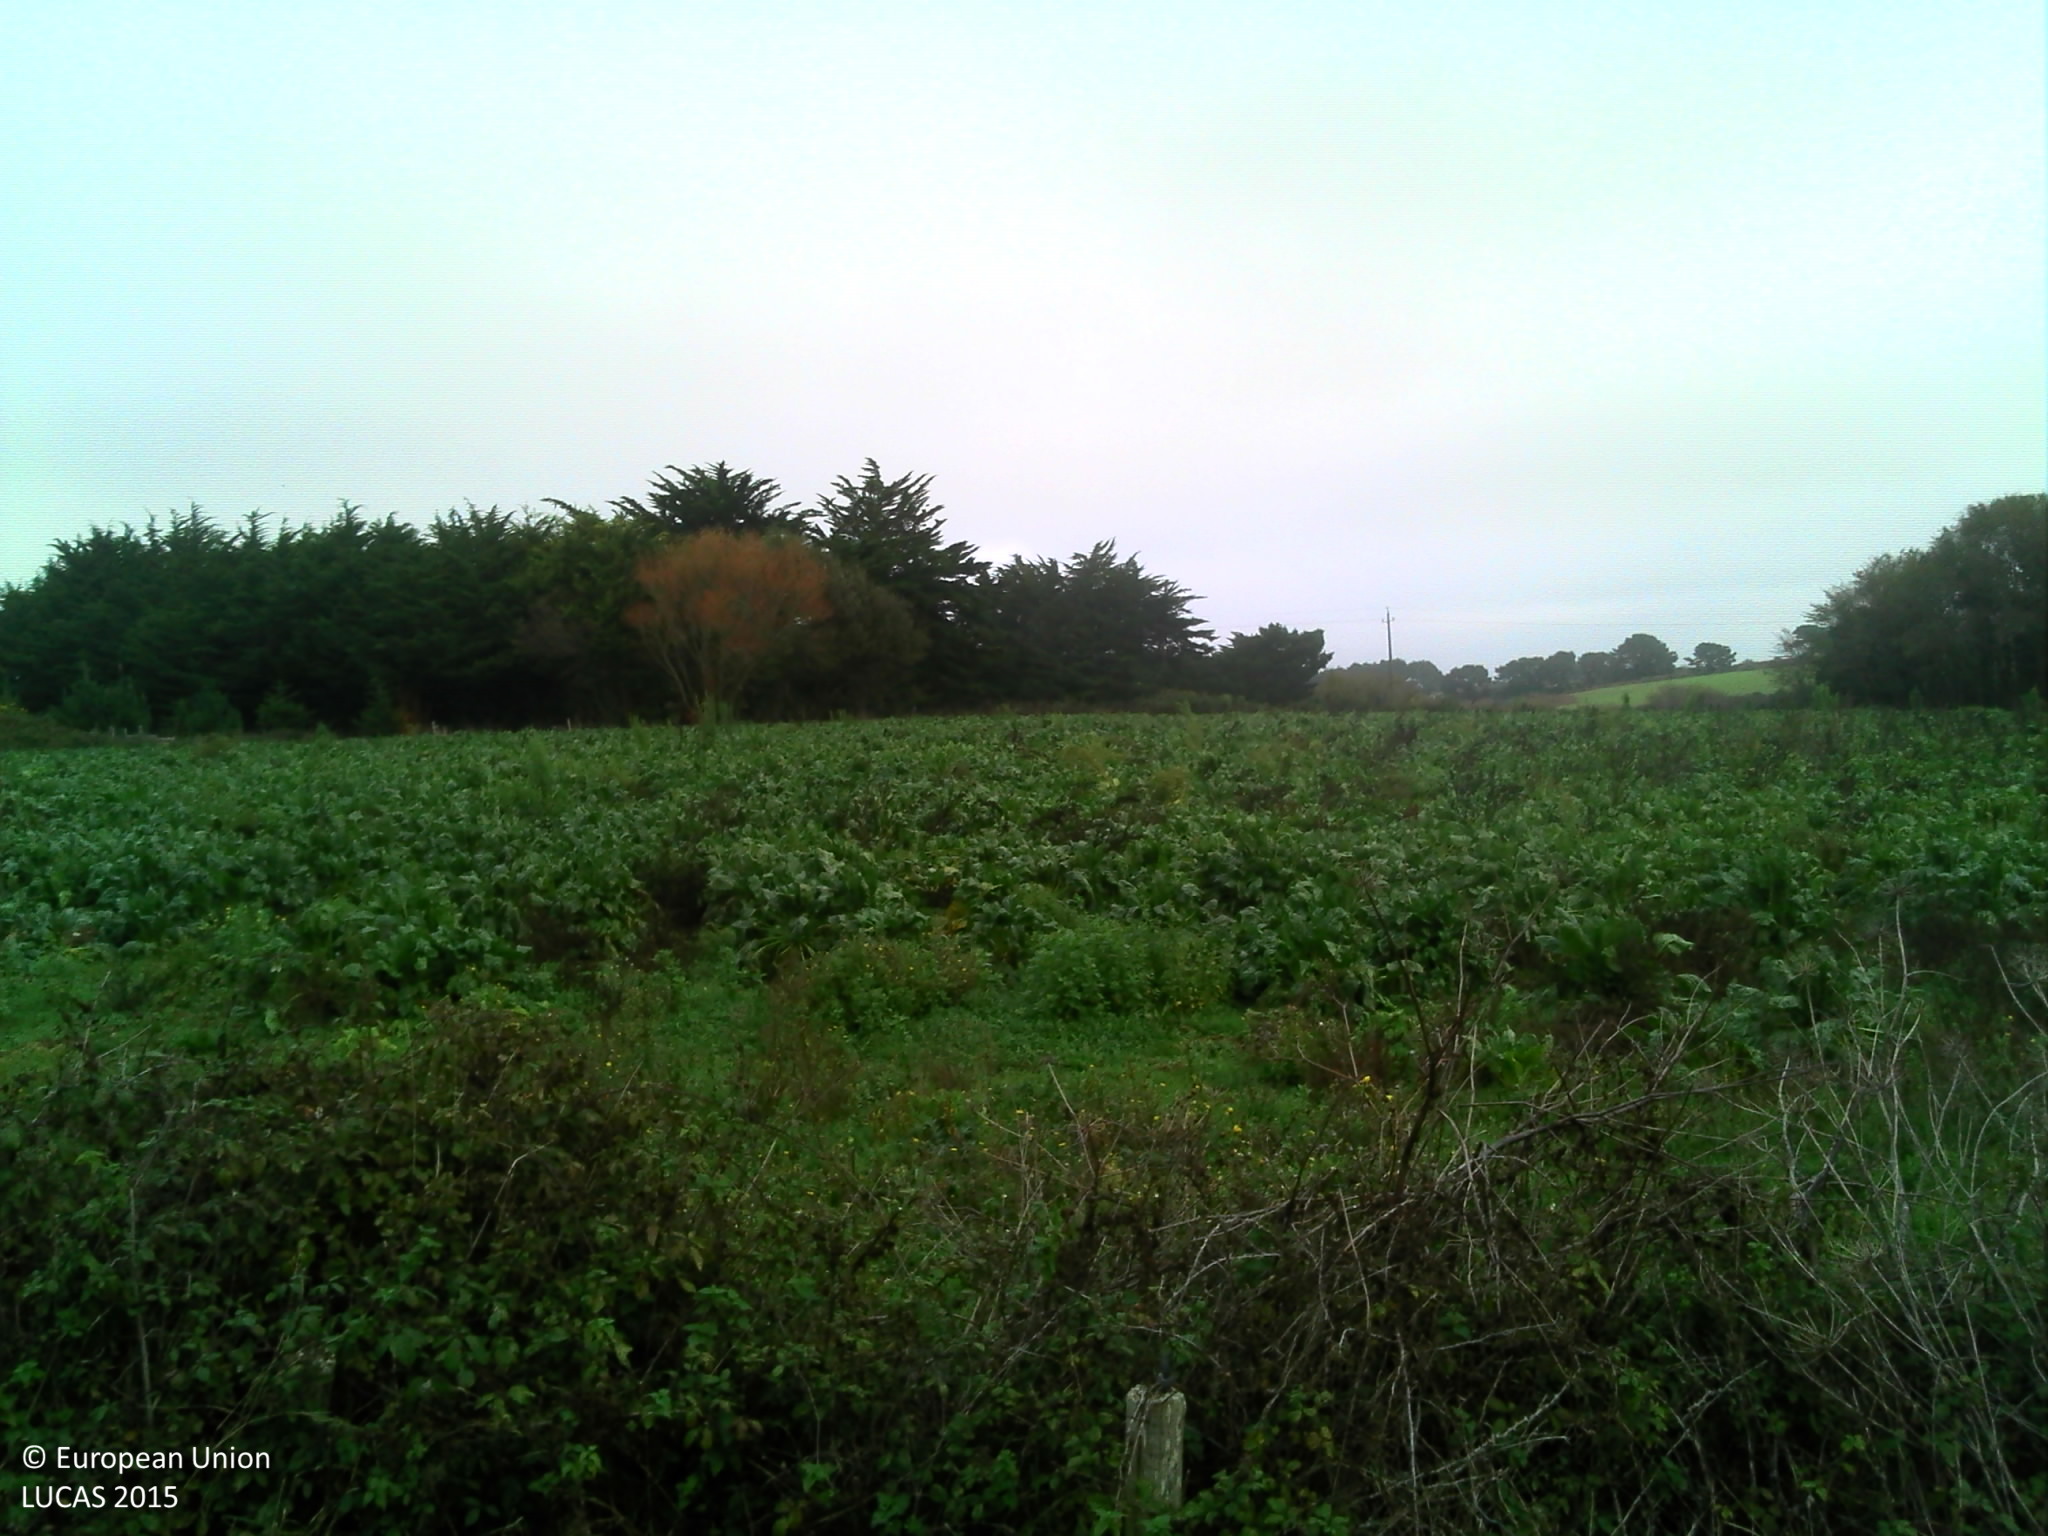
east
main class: Shrubland
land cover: Shrubland with sparse tree cover
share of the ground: > 75 %
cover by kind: shrubs 95 %, broadleaved forest trees 5 %
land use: Semi-natural and natural areas not in use
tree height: < 5 m
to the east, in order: Shrubland with sparse tree cover; Ditches and canals; Grass margins; Paved roads, cycling and walking lanes; Grass margins; Ditches and canals; Fences; Managed hedges; Sugar beet; Broadleaved woodland; Grassland without tree/shrub cover
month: November
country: FR
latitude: 47.3075
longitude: -3.1211
